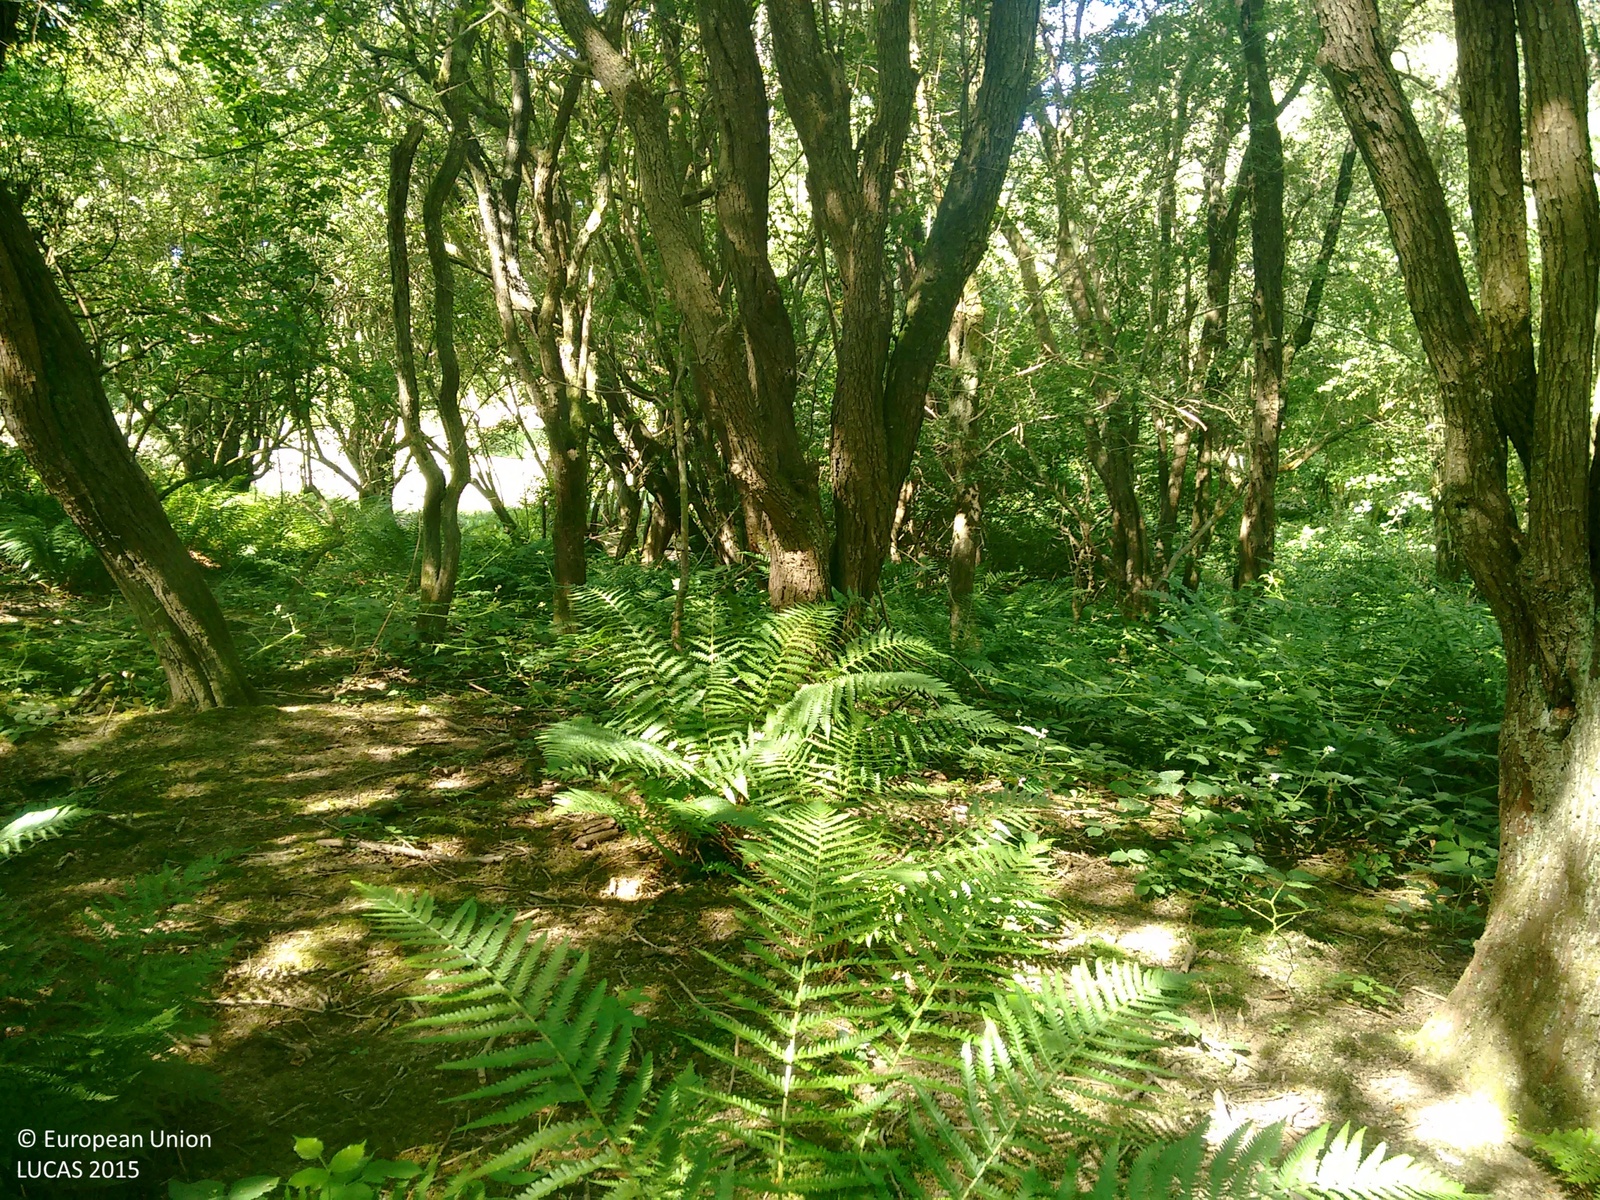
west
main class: Woodland
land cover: Broadleaved woodland
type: mesophytic deciduous forest
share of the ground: > 75 %
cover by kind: broadleaved forest trees 70 %, shrubs 30 %
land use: Sport
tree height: > 5 m
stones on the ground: < 10 %
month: July
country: GB
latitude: 51.0433
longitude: -0.2622
